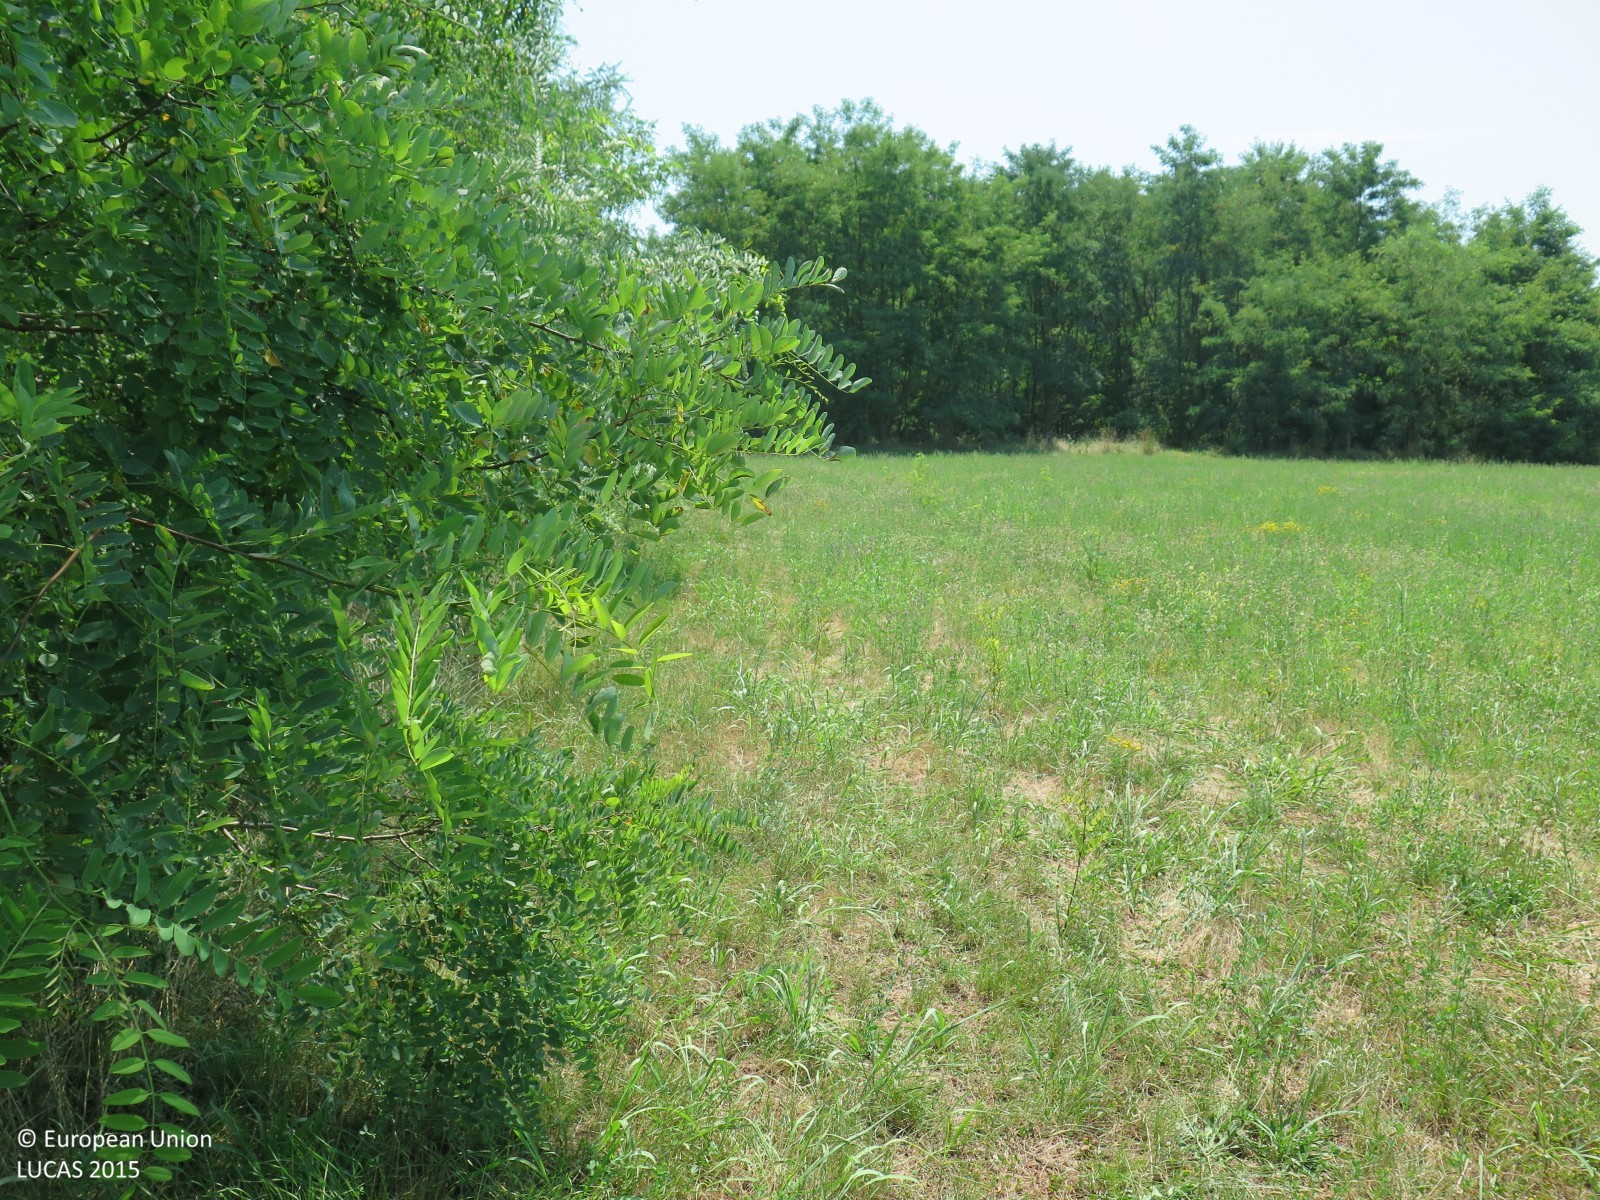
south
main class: Cropland
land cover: Temporary grasslands
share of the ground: > 75 %
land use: Agriculture (excluding fallow land and kitchen gardens)
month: July
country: HR
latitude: 45.4075
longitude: 13.5855
